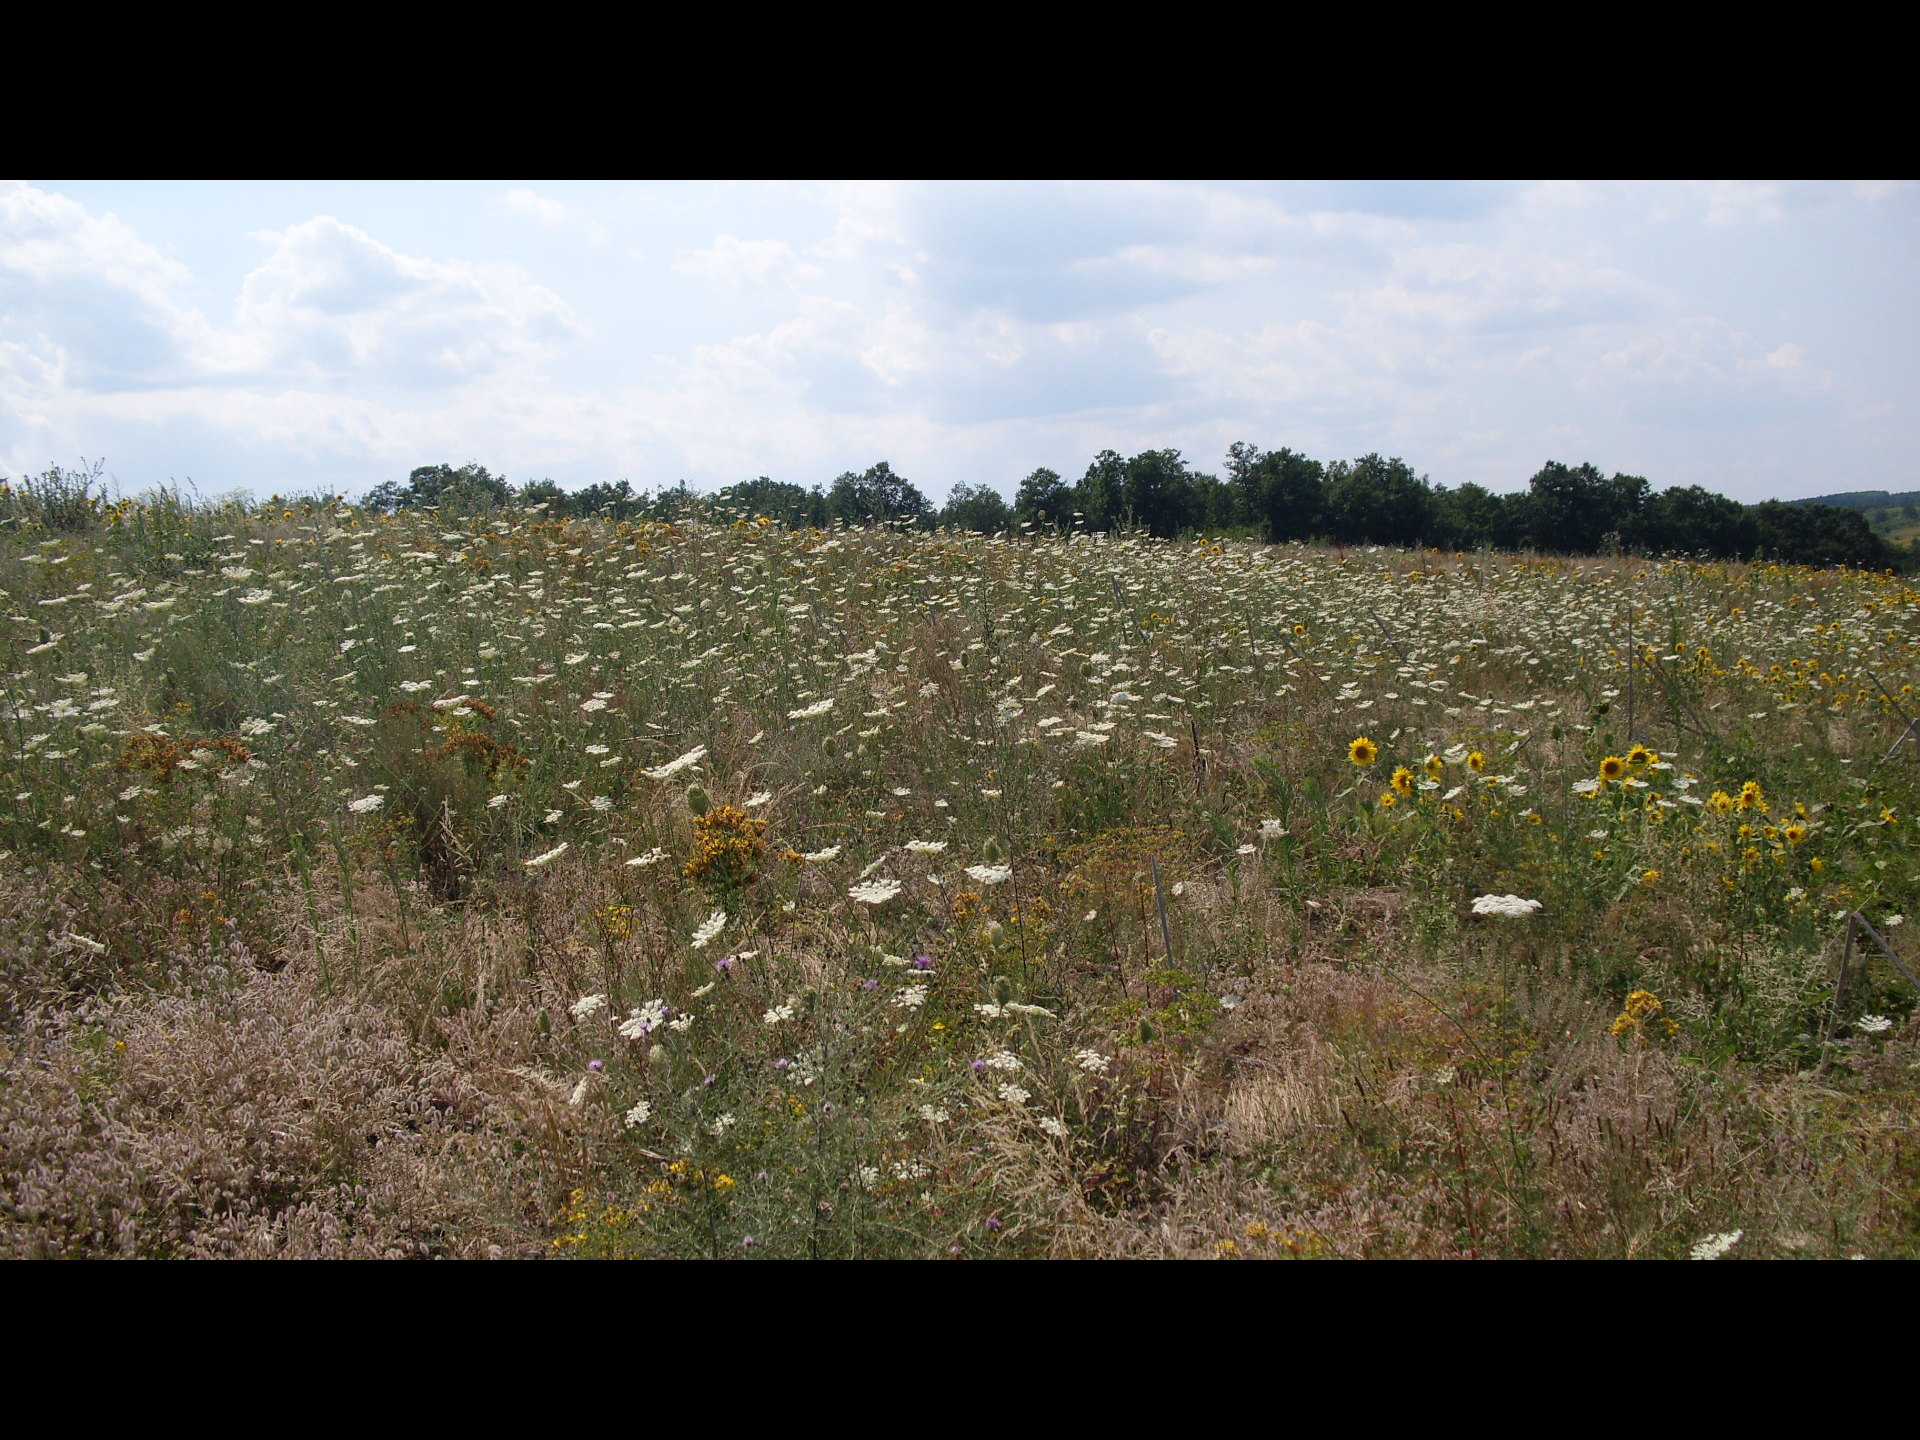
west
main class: Grassland
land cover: Spontaneously vegetated surfaces
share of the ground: > 75 %
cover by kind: herbaceous plants 100 %
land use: Fallow land
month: July
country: BG
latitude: 43.7625
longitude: 22.5918
